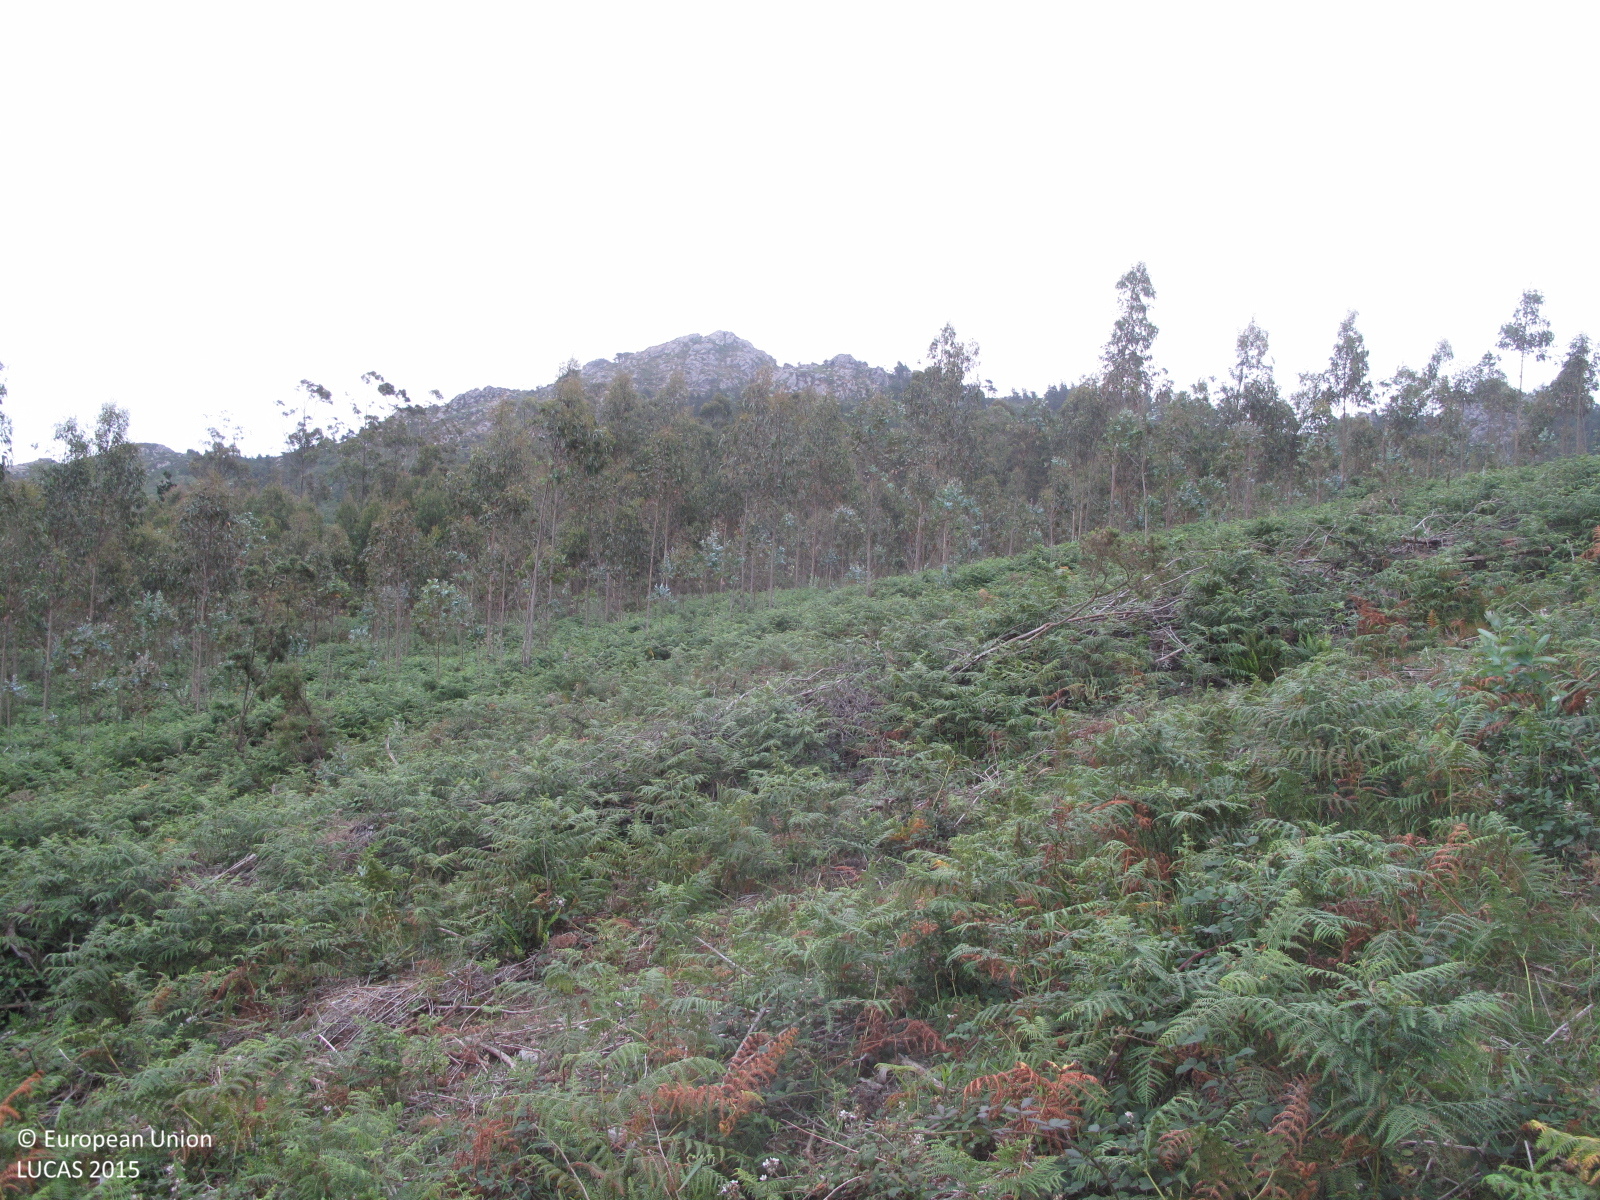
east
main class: Woodland
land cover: Broadleaved woodland
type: exotic forest
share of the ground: > 75 %
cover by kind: broadleaved forest trees 90 %, shrubs 10 %
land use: Forestry
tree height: > 5 m
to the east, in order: Broadleaved woodland; Shrubland without tree cover; Broadleaved woodland; Tracks; Broadleaved woodland
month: July
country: ES
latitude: 43.7177
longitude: -7.9074
